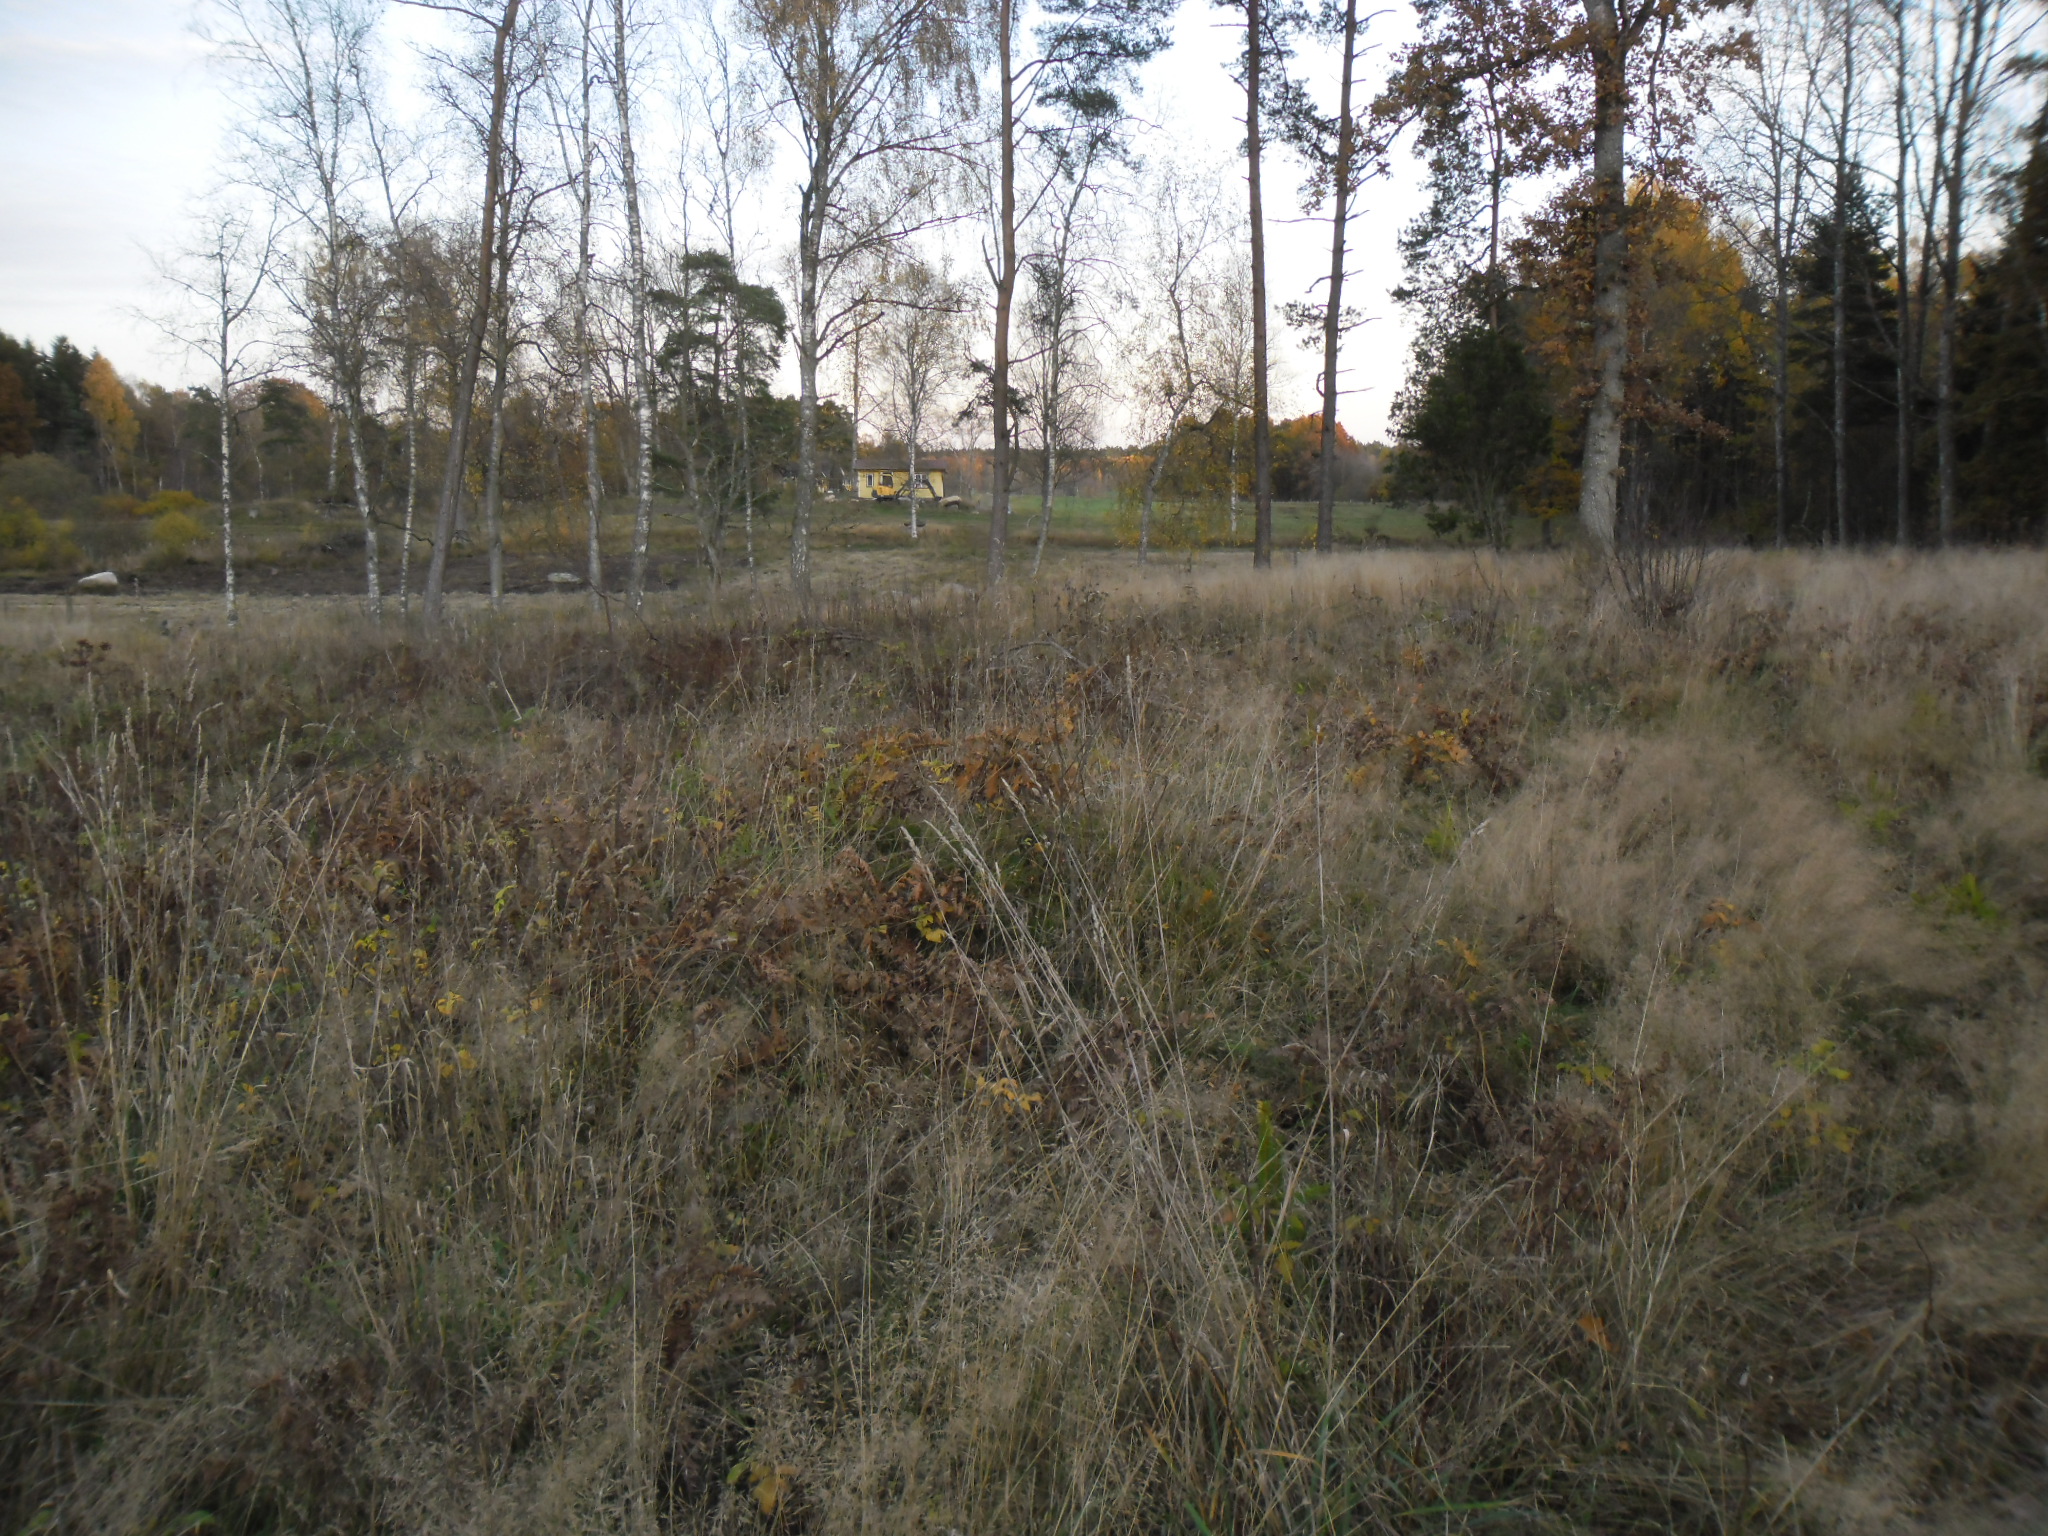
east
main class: Grassland
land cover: Grassland without tree/shrub cover
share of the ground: > 75 %
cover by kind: herbaceous plants 100 %
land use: Agriculture (excluding fallow land and kitchen gardens)
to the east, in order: Grassland without tree/shrub cover; Abandoned hedges; Fences; Dry stone walls; Grassland without tree/shrub cover; Ditches and canals; Grassland without tree/shrub cover
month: October
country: SE
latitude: 56.2229
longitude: 13.7552
